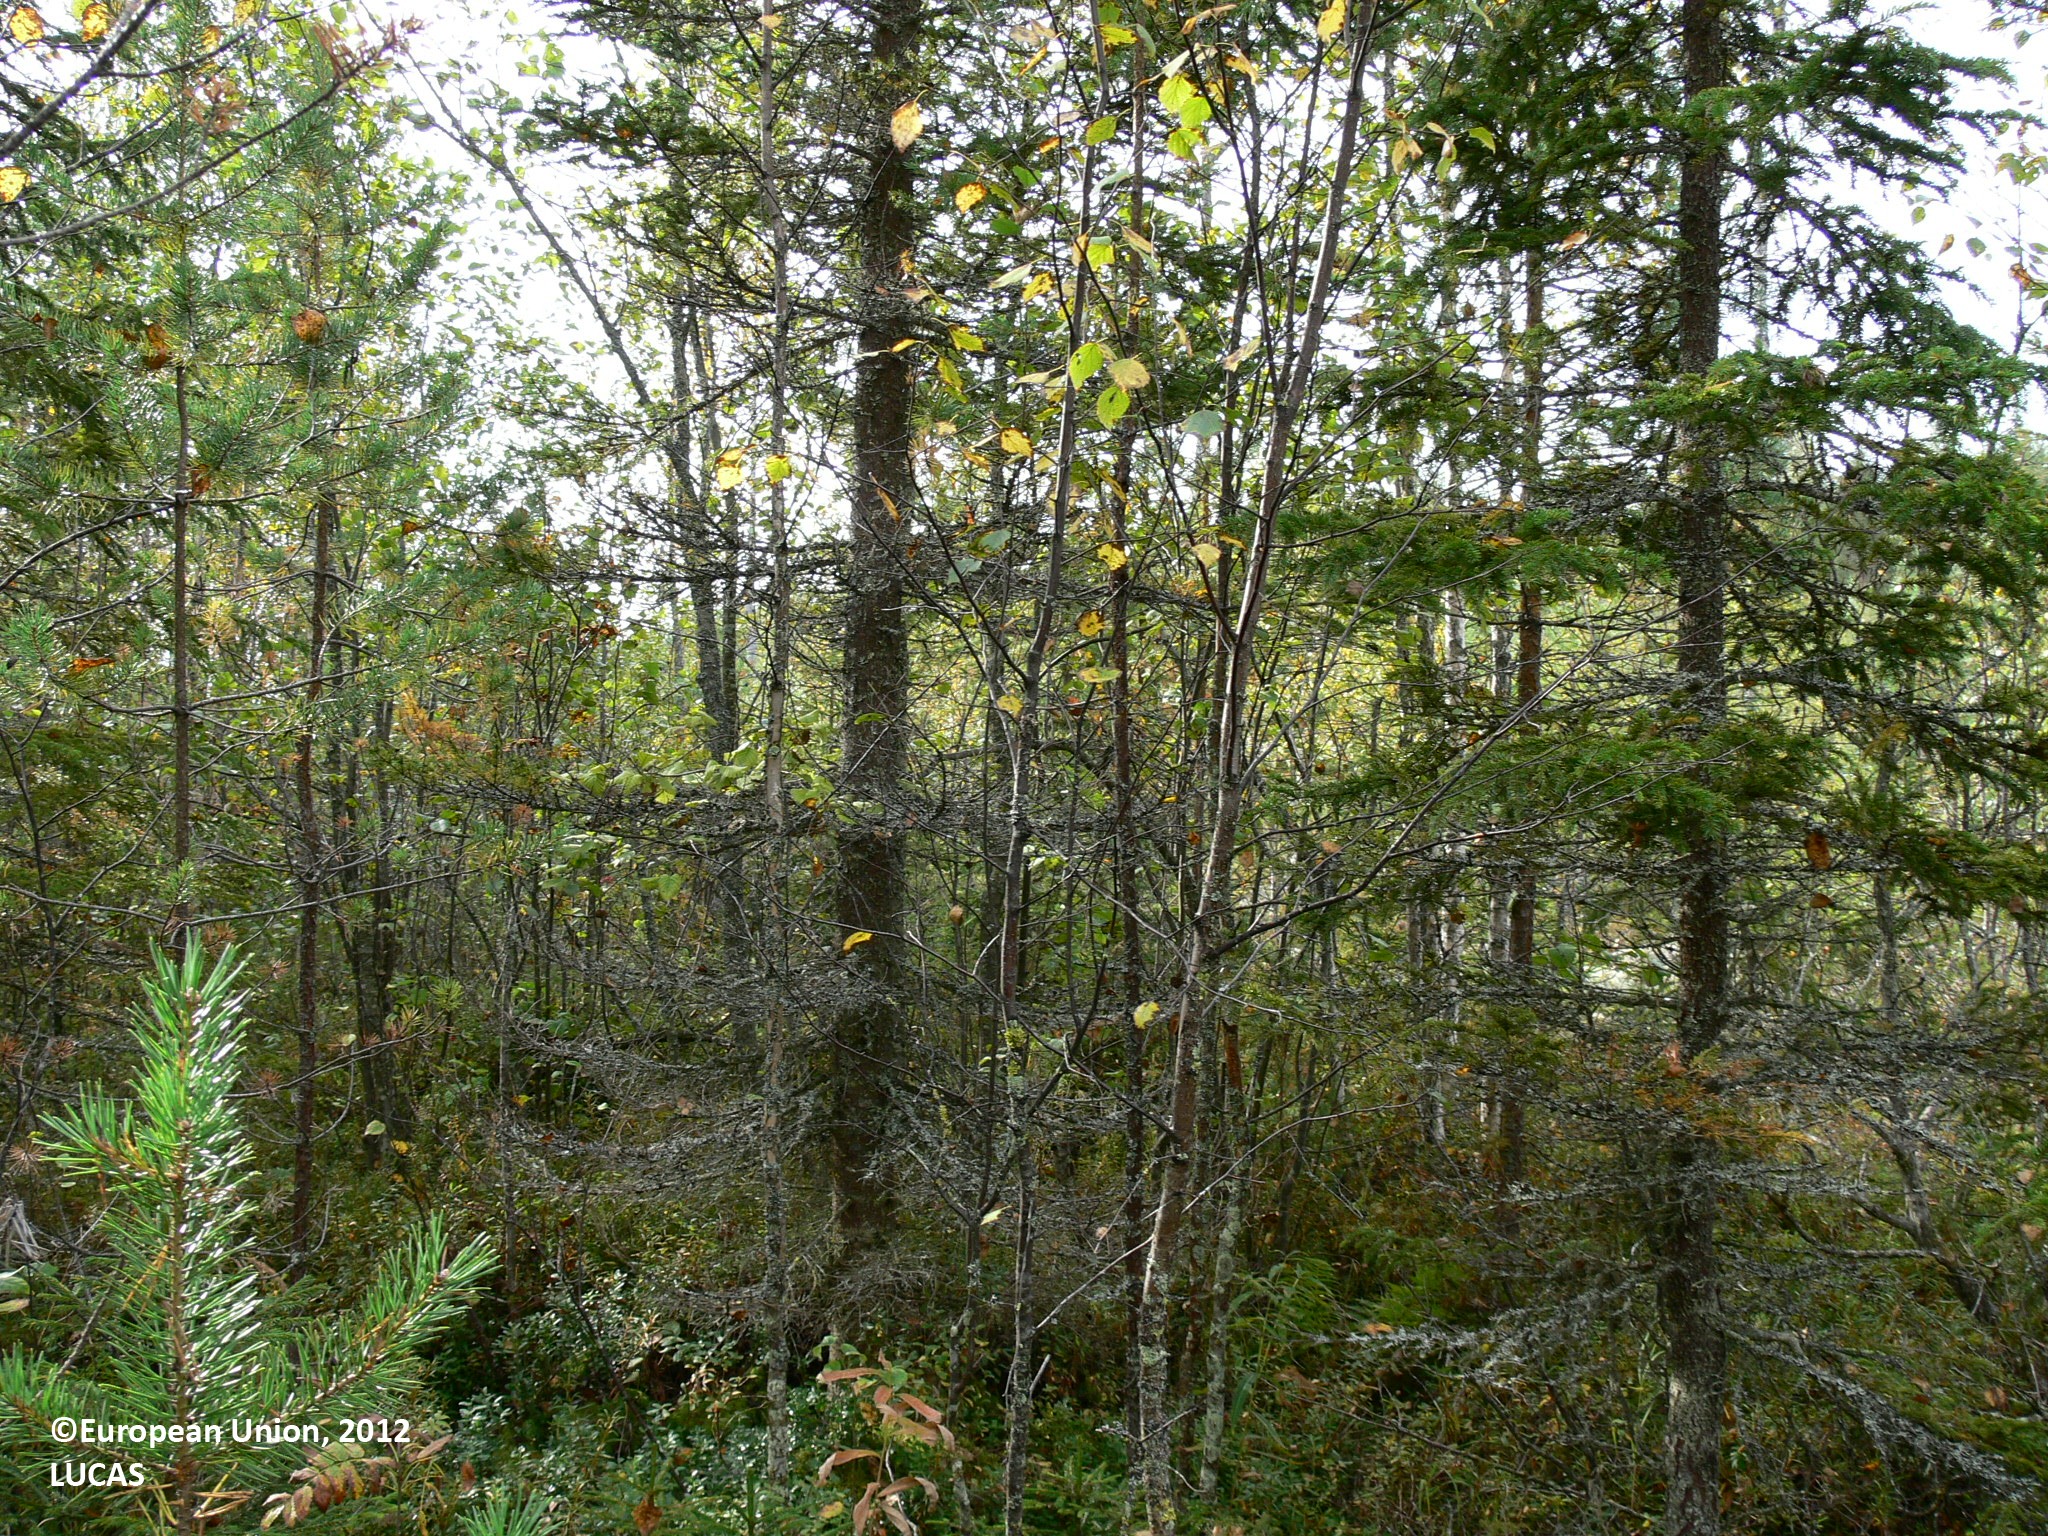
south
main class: Woodland
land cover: Pine dominated mixed woodland
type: boreal forest
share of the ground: > 75 %
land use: Forestry
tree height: < 5 m
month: September
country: FI
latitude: 63.0905
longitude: 30.0815
